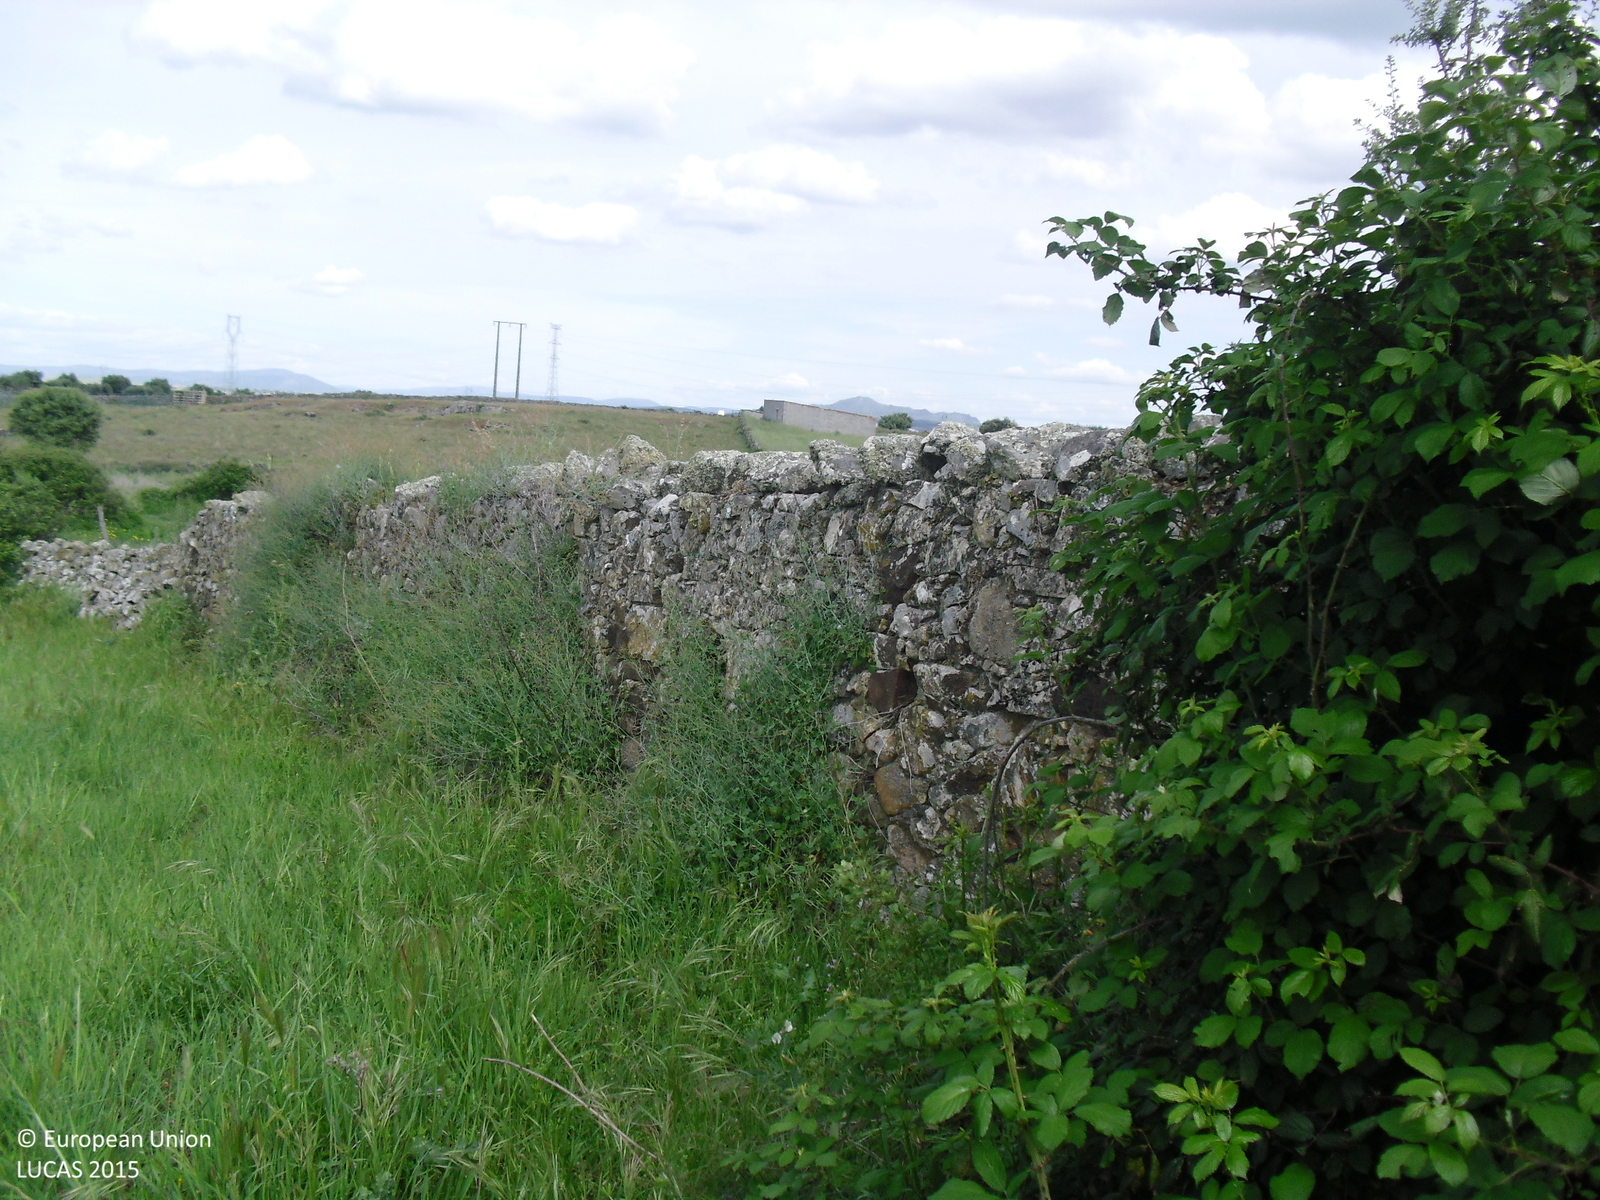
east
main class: Grassland
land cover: Grassland without tree/shrub cover
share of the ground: > 75 %
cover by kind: herbaceous plants 95 %, shrubs 5 %
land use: Agriculture (excluding fallow land and kitchen gardens)
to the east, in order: Dry stone walls; Grassland without tree/shrub cover; Dry stone walls; Grassland without tree/shrub cover; Dry stone walls; Grassland without tree/shrub cover; Dry stone walls; Grassland without tree/shrub cover; Shruby margins; Grassland without tree/shrub cover; Dry stone walls; Grassland without tree/shrub cover; Electric lines; Grassland without tree/shrub cover; Dry stone walls; Tracks; Dry stone walls; Grassland without tree/shrub cover
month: April
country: ES
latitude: 39.3296
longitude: -6.0093
